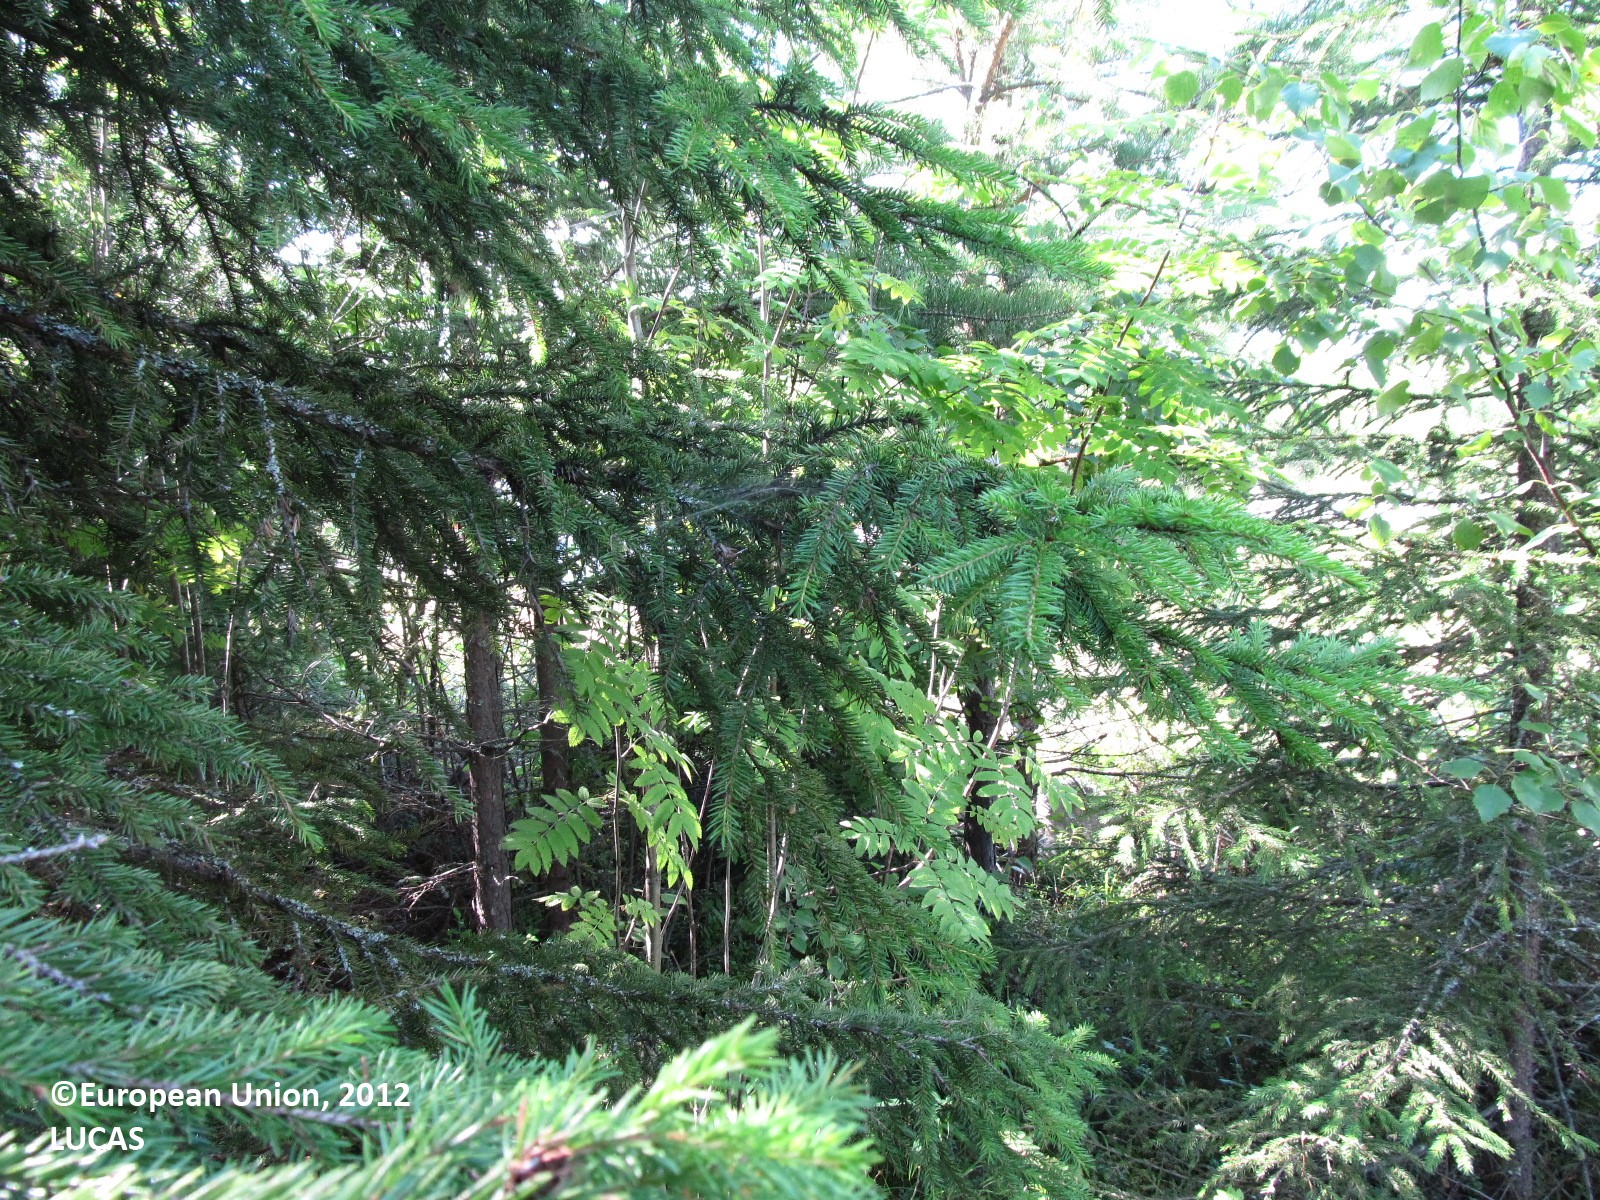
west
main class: Woodland
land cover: Spruce dominated mixed woodland
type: boreal forest
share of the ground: > 75 %
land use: Forestry
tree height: > 5 m
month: July
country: FI
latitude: 61.9427
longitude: 28.1277
